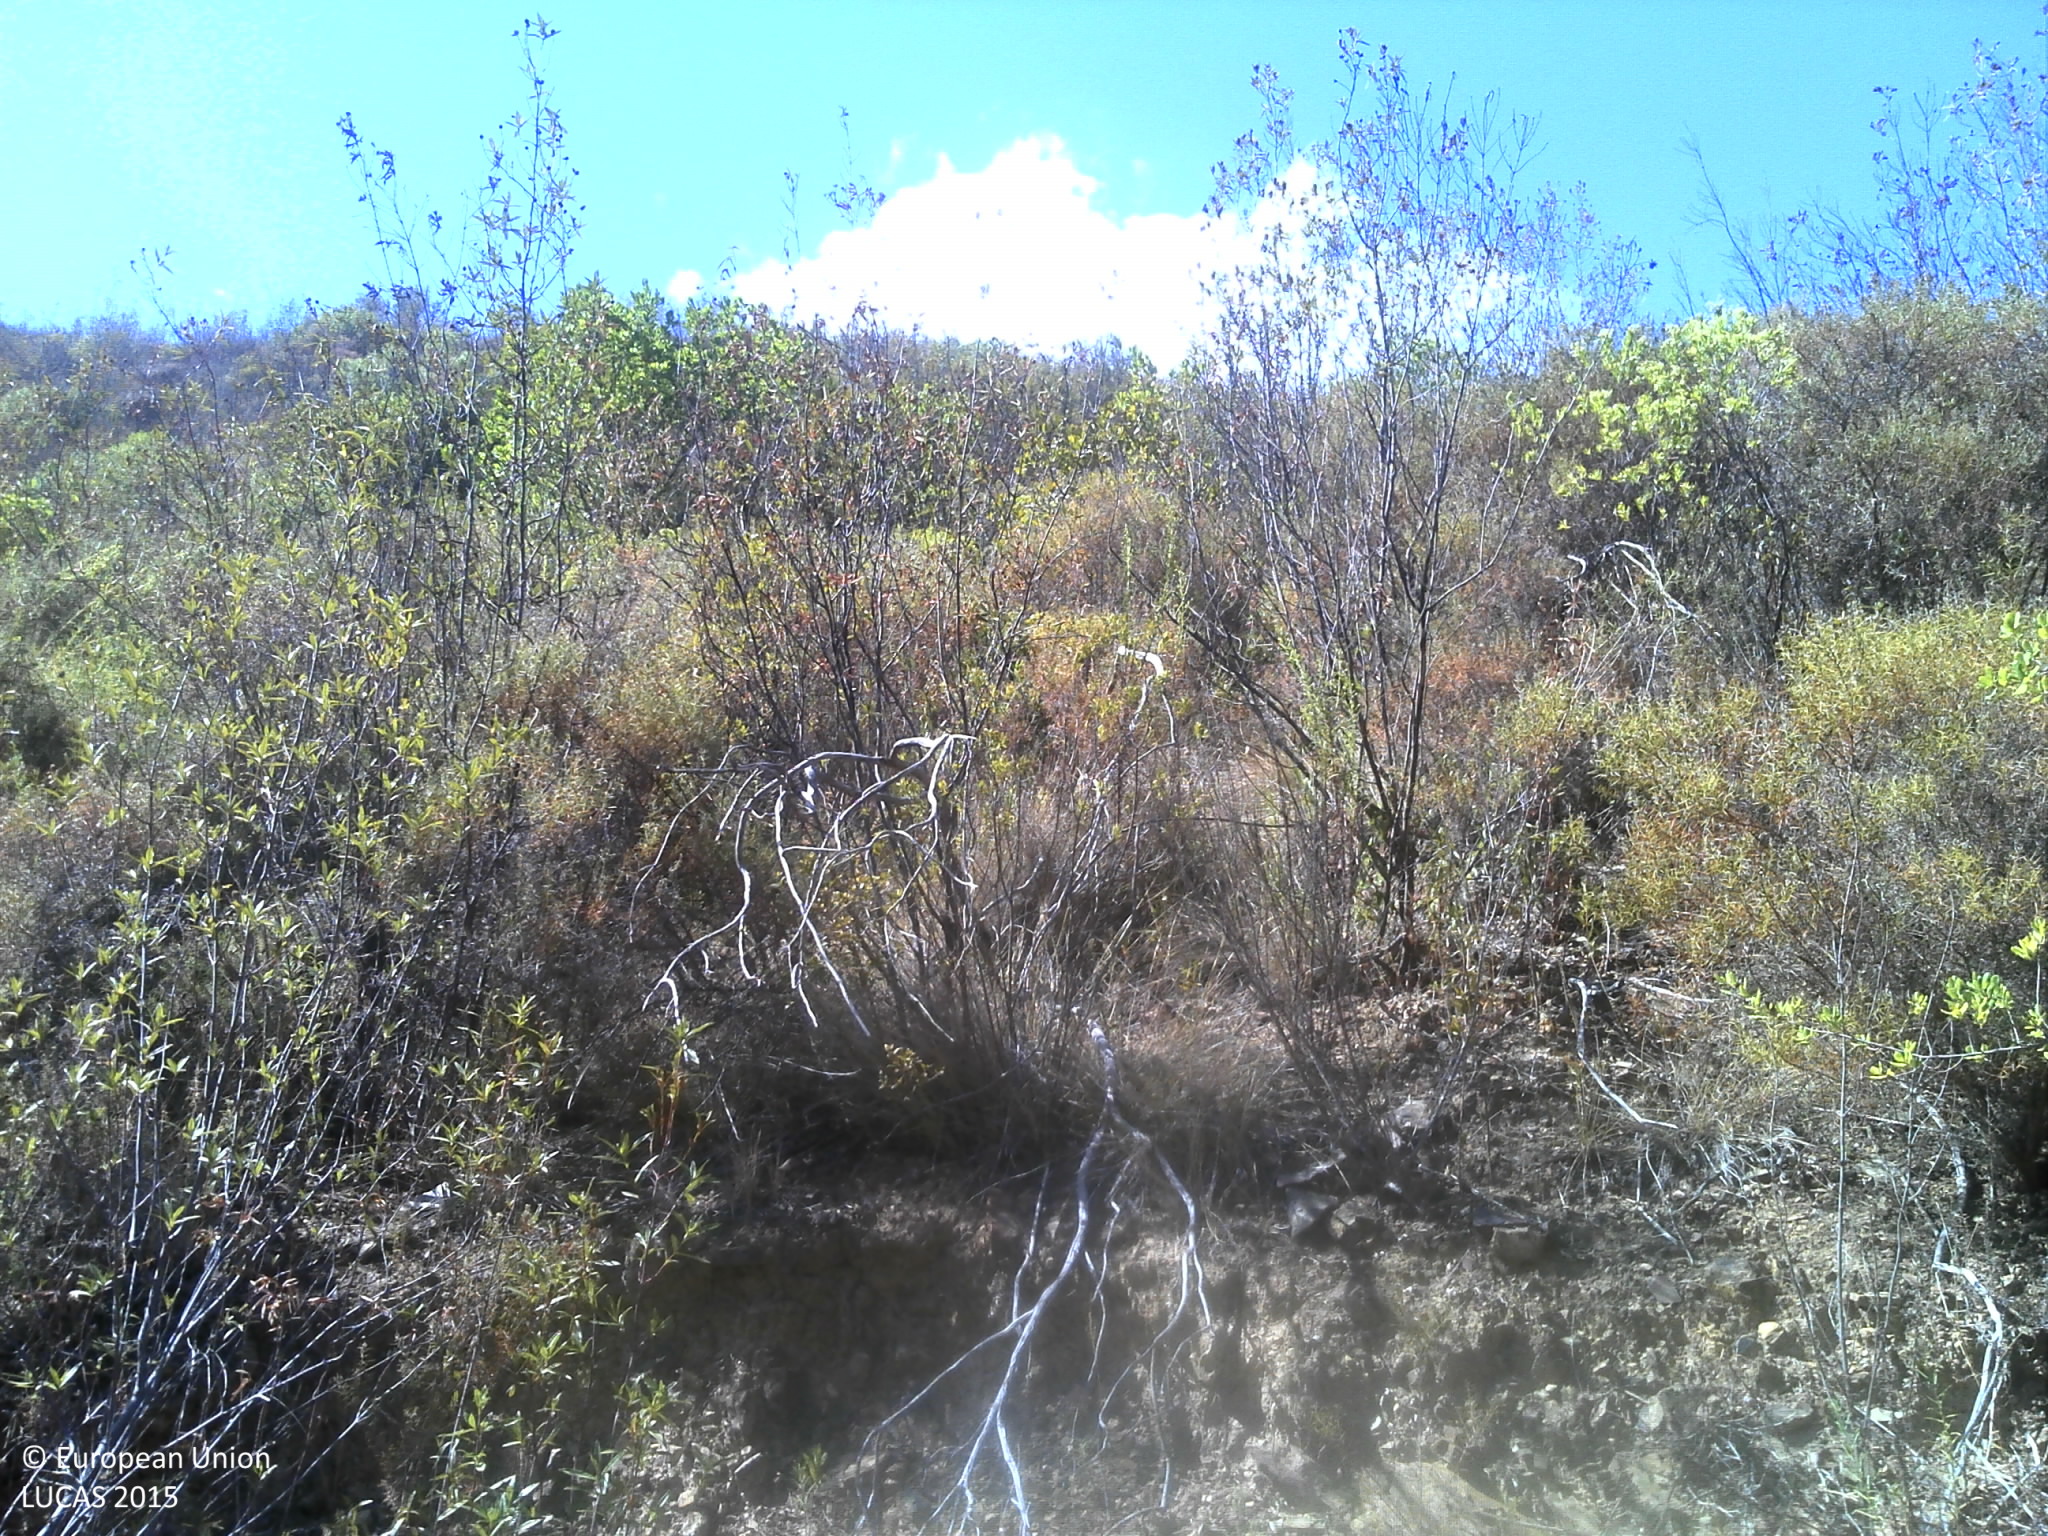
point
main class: Shrubland
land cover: Shrubland without tree cover
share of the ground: 50 - 75 %
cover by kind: shrubs 75 %, unconsolidated bare surface 25 %
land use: Abandoned areas
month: September
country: PT
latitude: 37.3402
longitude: -8.2292
